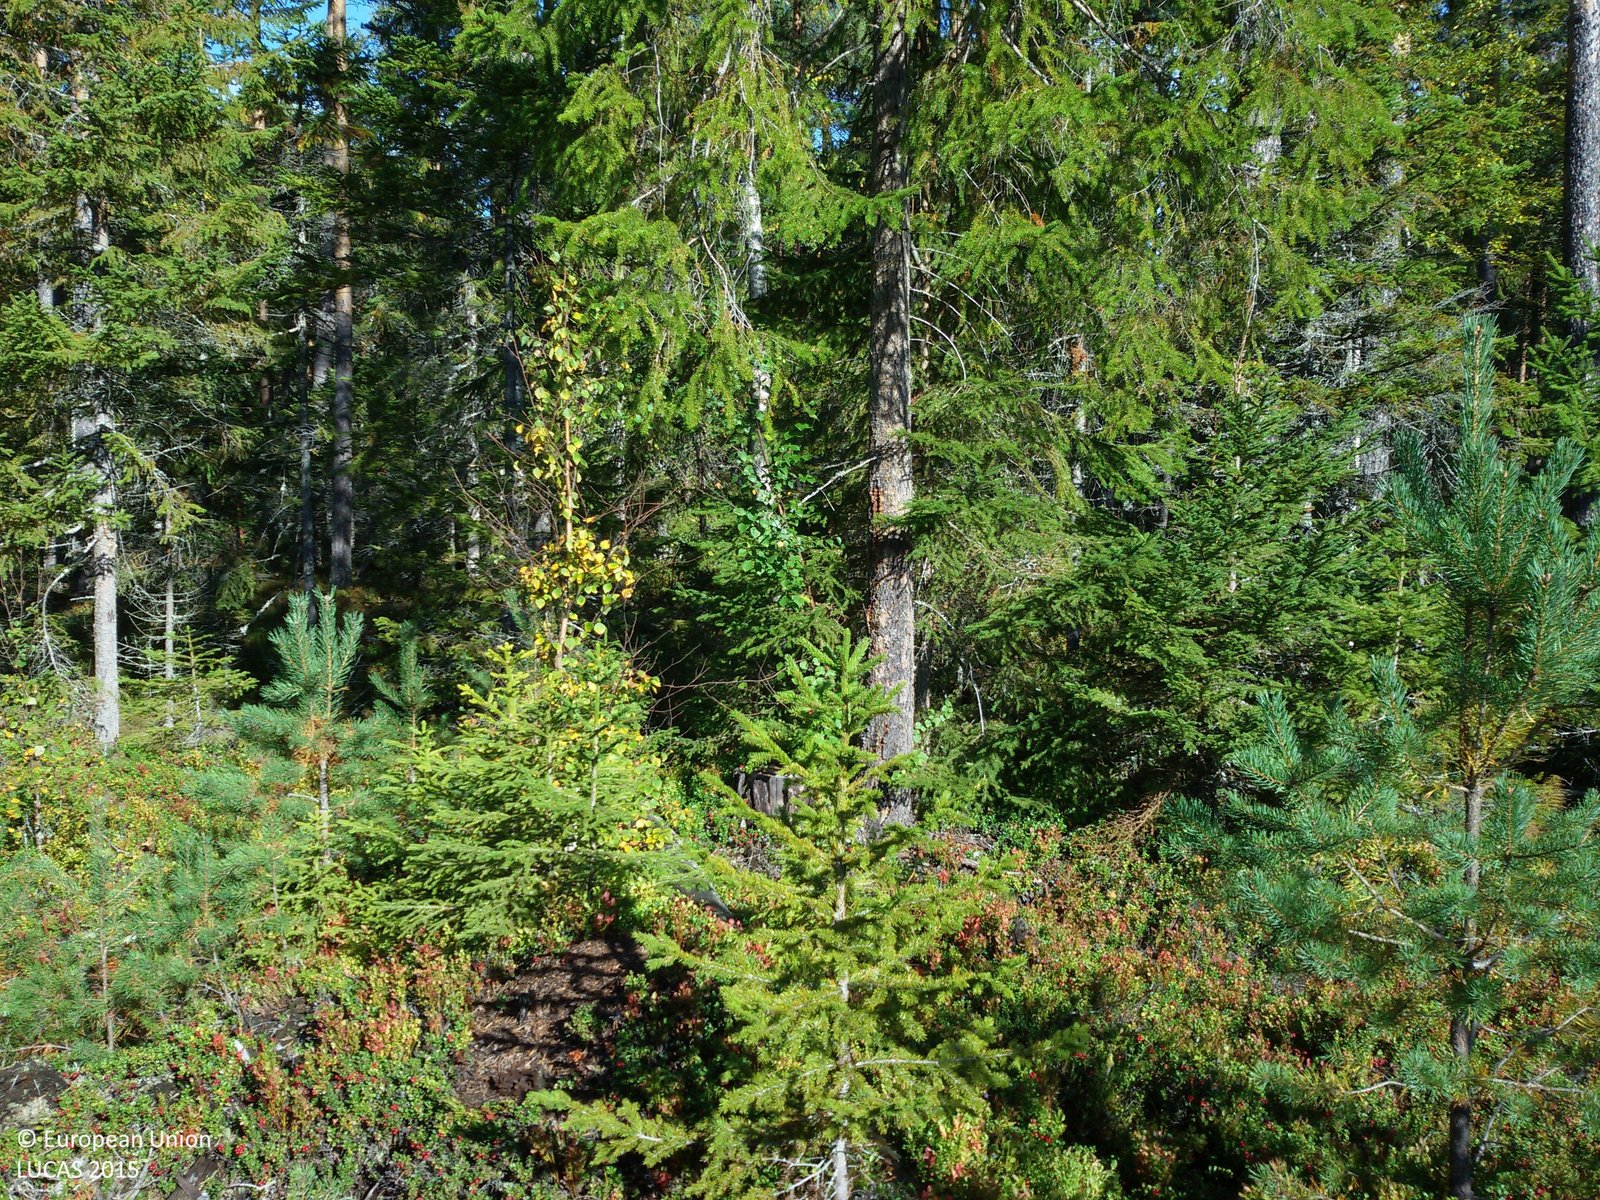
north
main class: Woodland
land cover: Pine dominated coniferous woodland
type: boreal forest
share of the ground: > 75 %
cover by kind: coniferous forest trees 90 %, shrubs 10 %
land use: Forestry
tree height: < 5 m
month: September
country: SE
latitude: 60.7721
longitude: 14.6322
